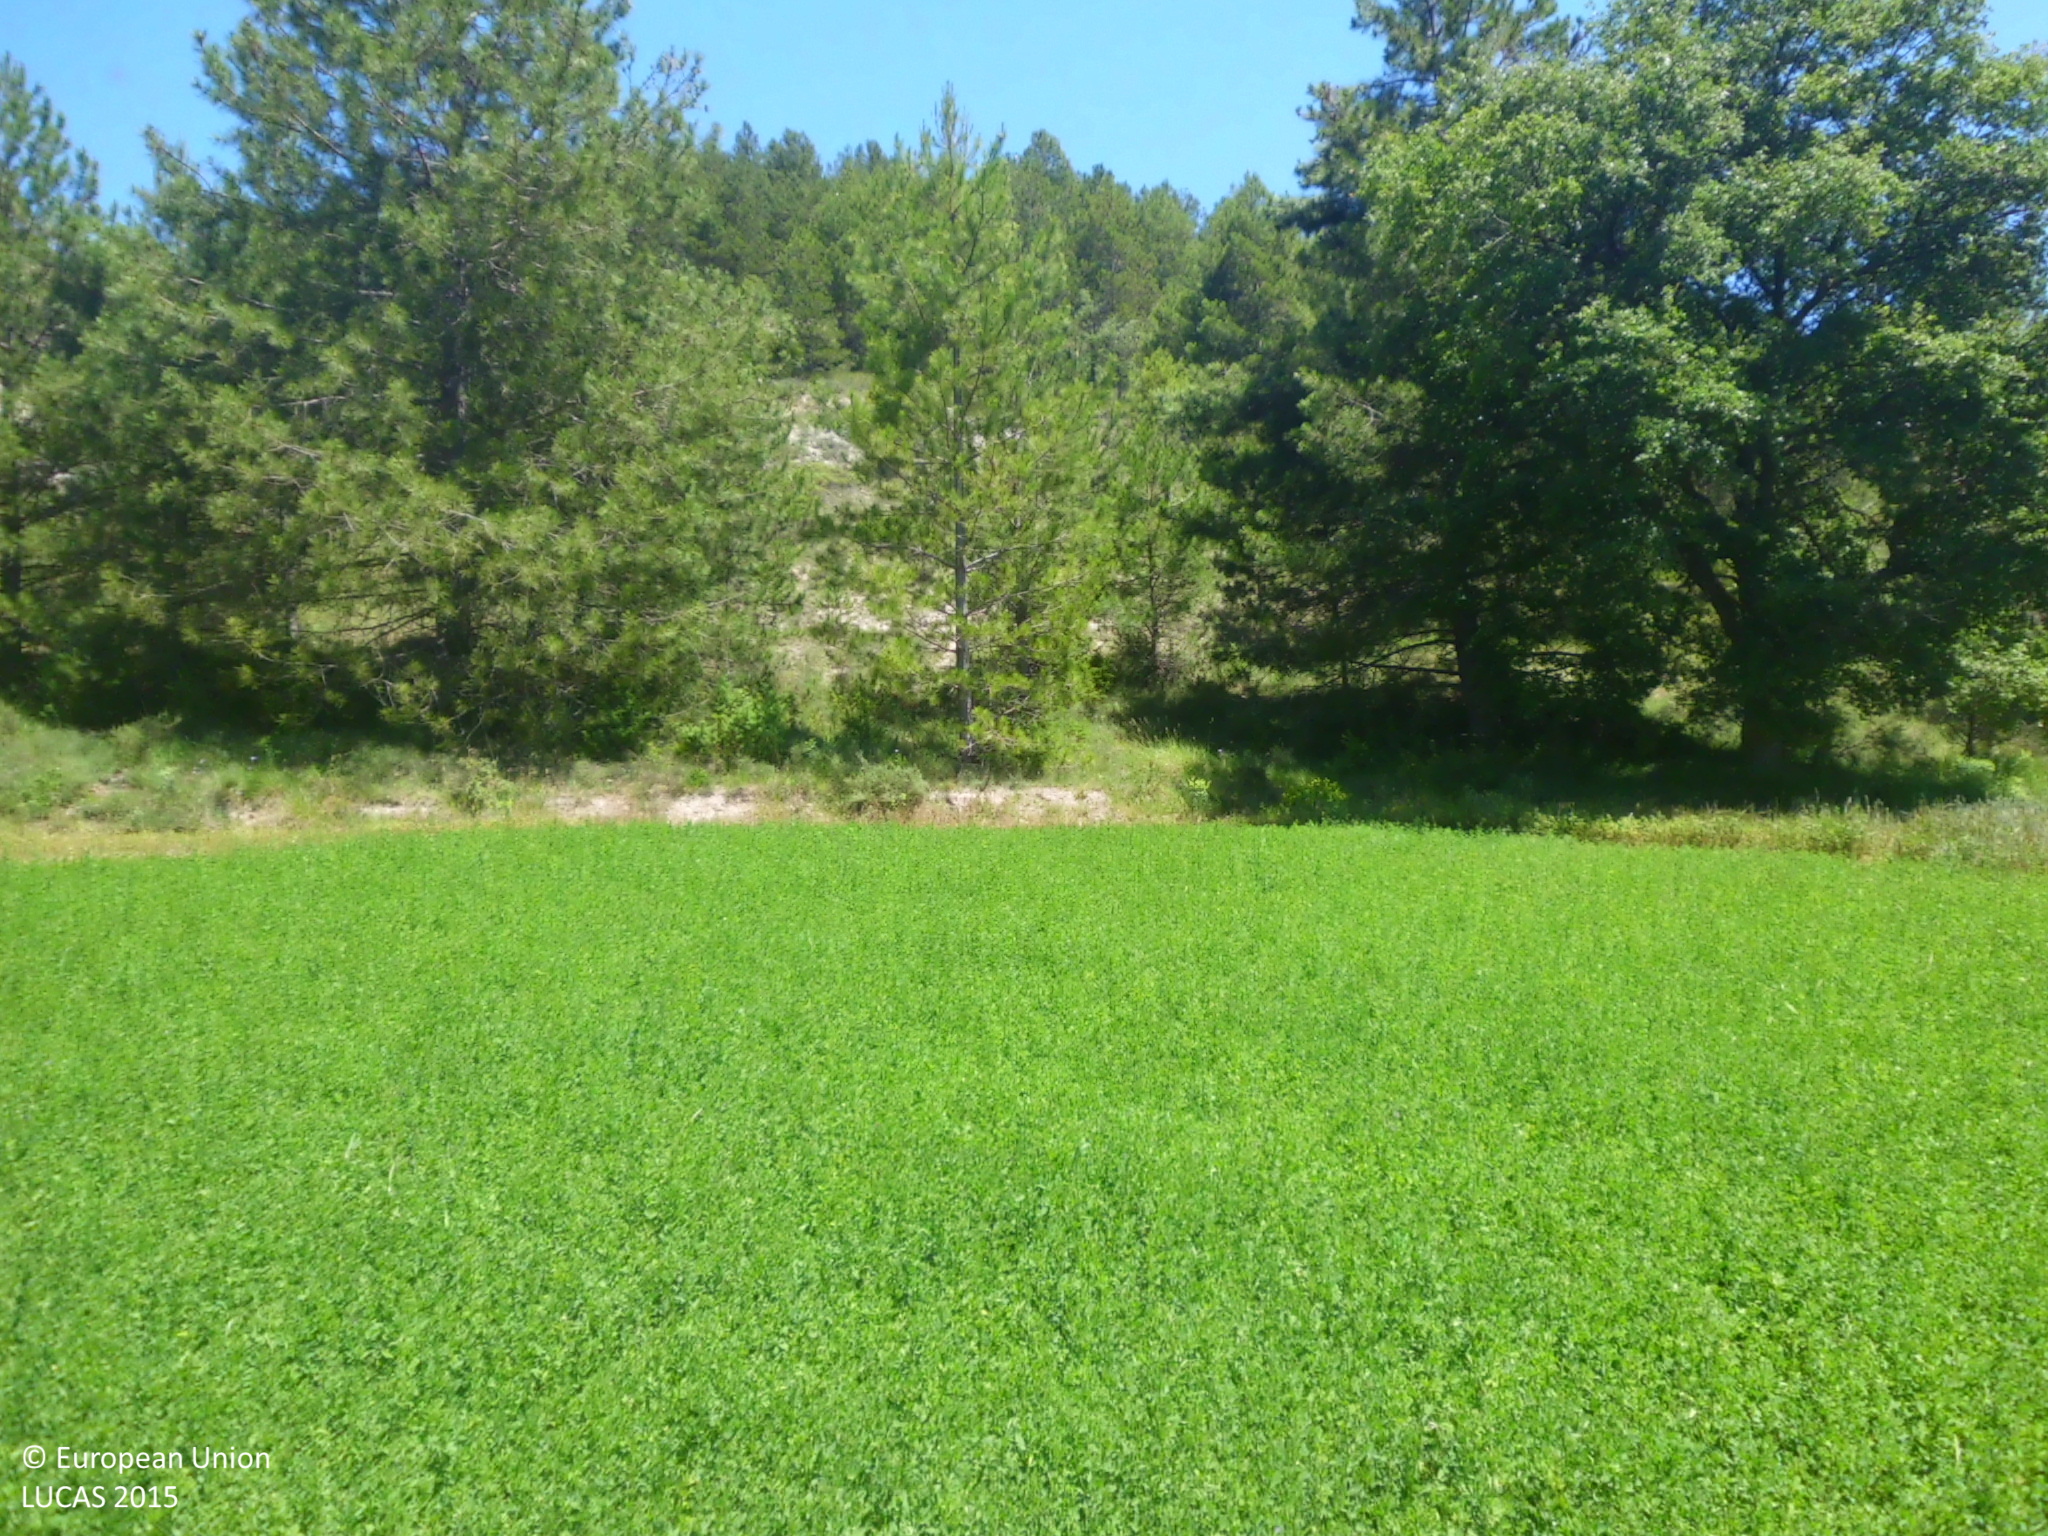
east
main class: Cropland
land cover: Lucerne
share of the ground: > 75 %
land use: Agriculture (excluding fallow land and kitchen gardens)
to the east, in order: Lucerne; Pine dominated coniferous woodland; Rock outcrops; Pine dominated coniferous woodland; Barley
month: June
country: ES
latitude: 42.8186
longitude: -3.4050
